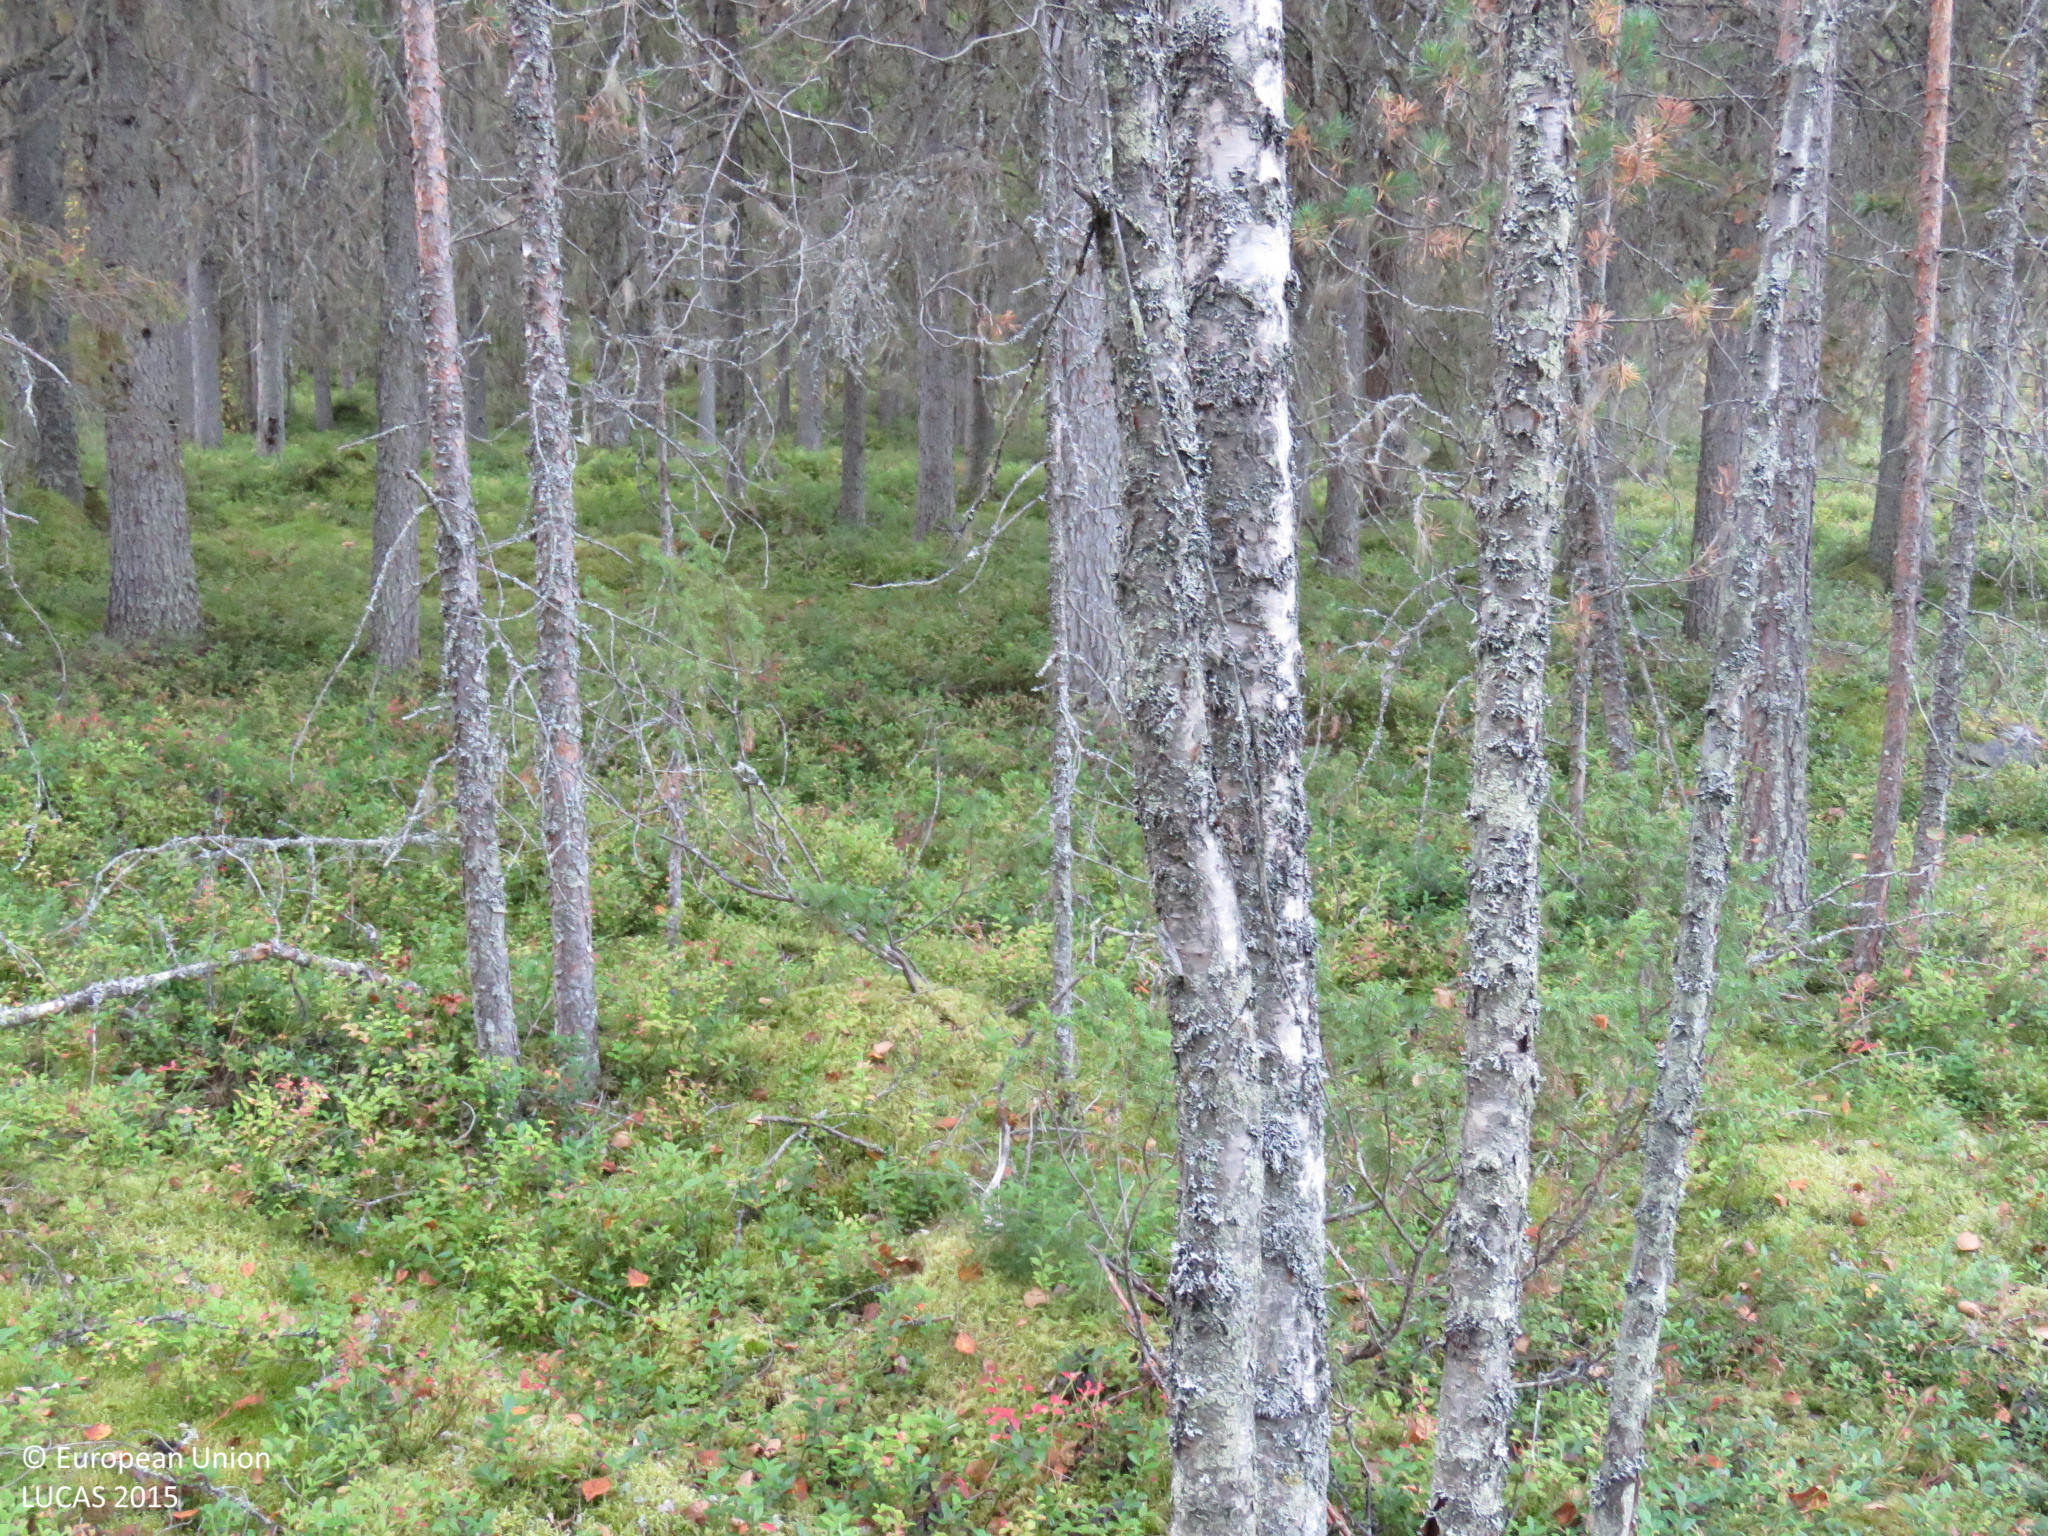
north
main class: Woodland
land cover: Other coniferous woodland
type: boreal forest
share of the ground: > 75 %
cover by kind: coniferous forest trees 70 %, shrubs 15 %, broadleaved forest trees 10 %, lichens and mosses 5 %
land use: Forestry
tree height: > 5 m
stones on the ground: < 10 %
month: September
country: FI
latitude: 65.0389
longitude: 26.3940
